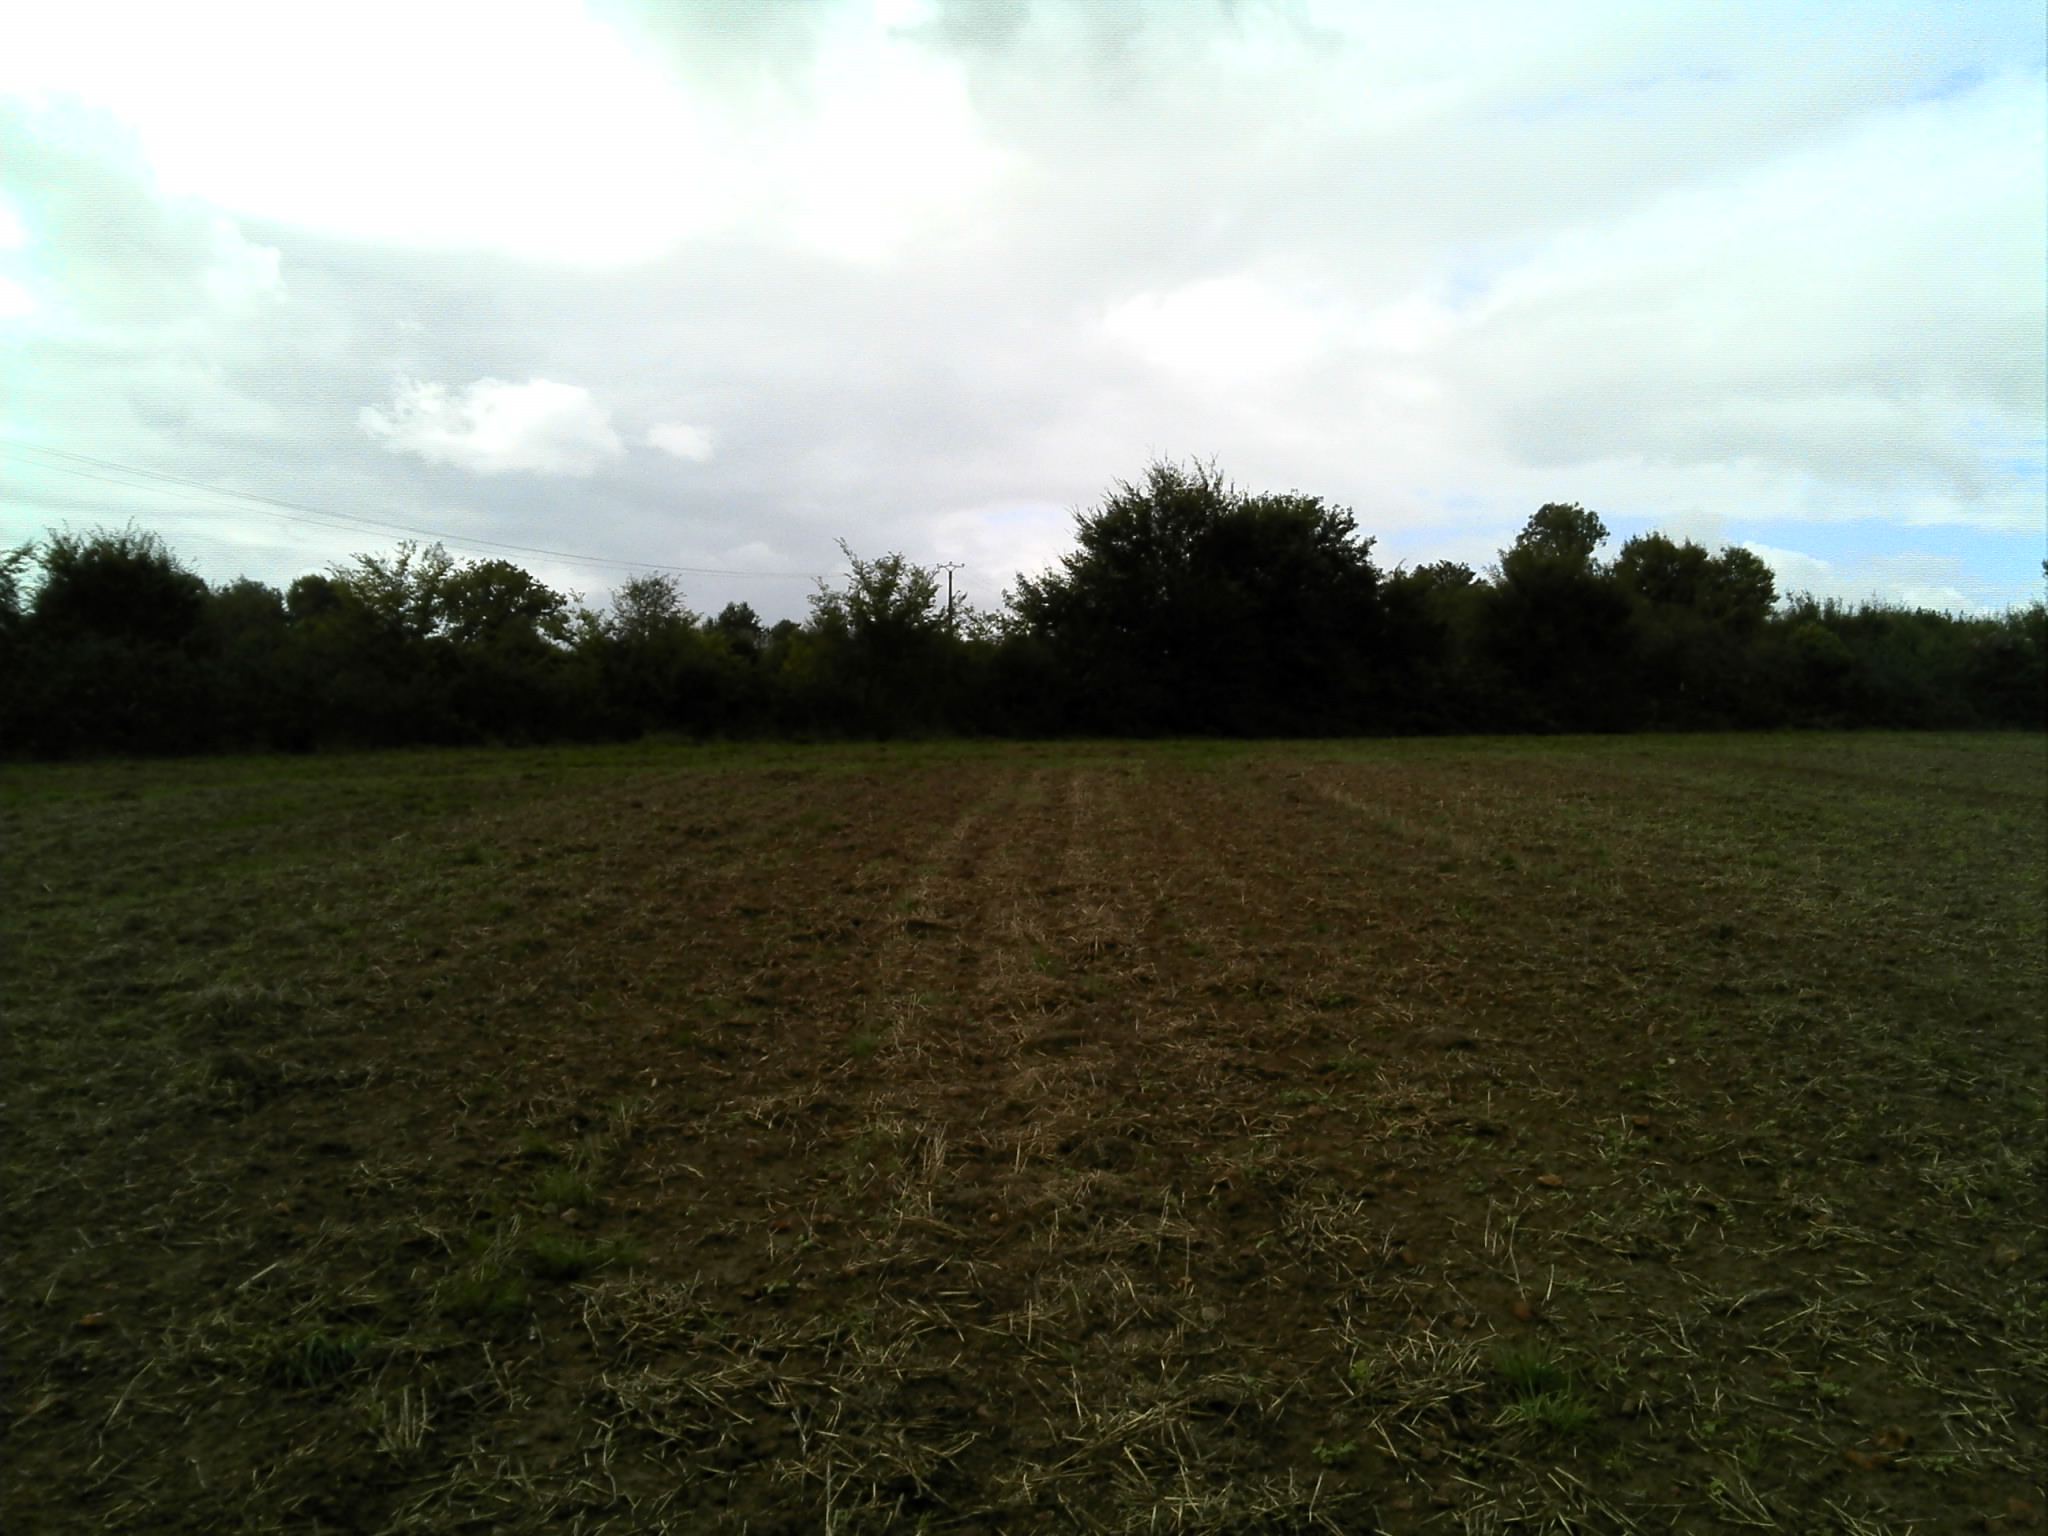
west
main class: Cropland
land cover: Common wheat
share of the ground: 10 - 25 %
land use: Agriculture (excluding fallow land and kitchen gardens)
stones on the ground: < 10 %
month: September
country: FR
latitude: 48.2393
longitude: 0.6189
